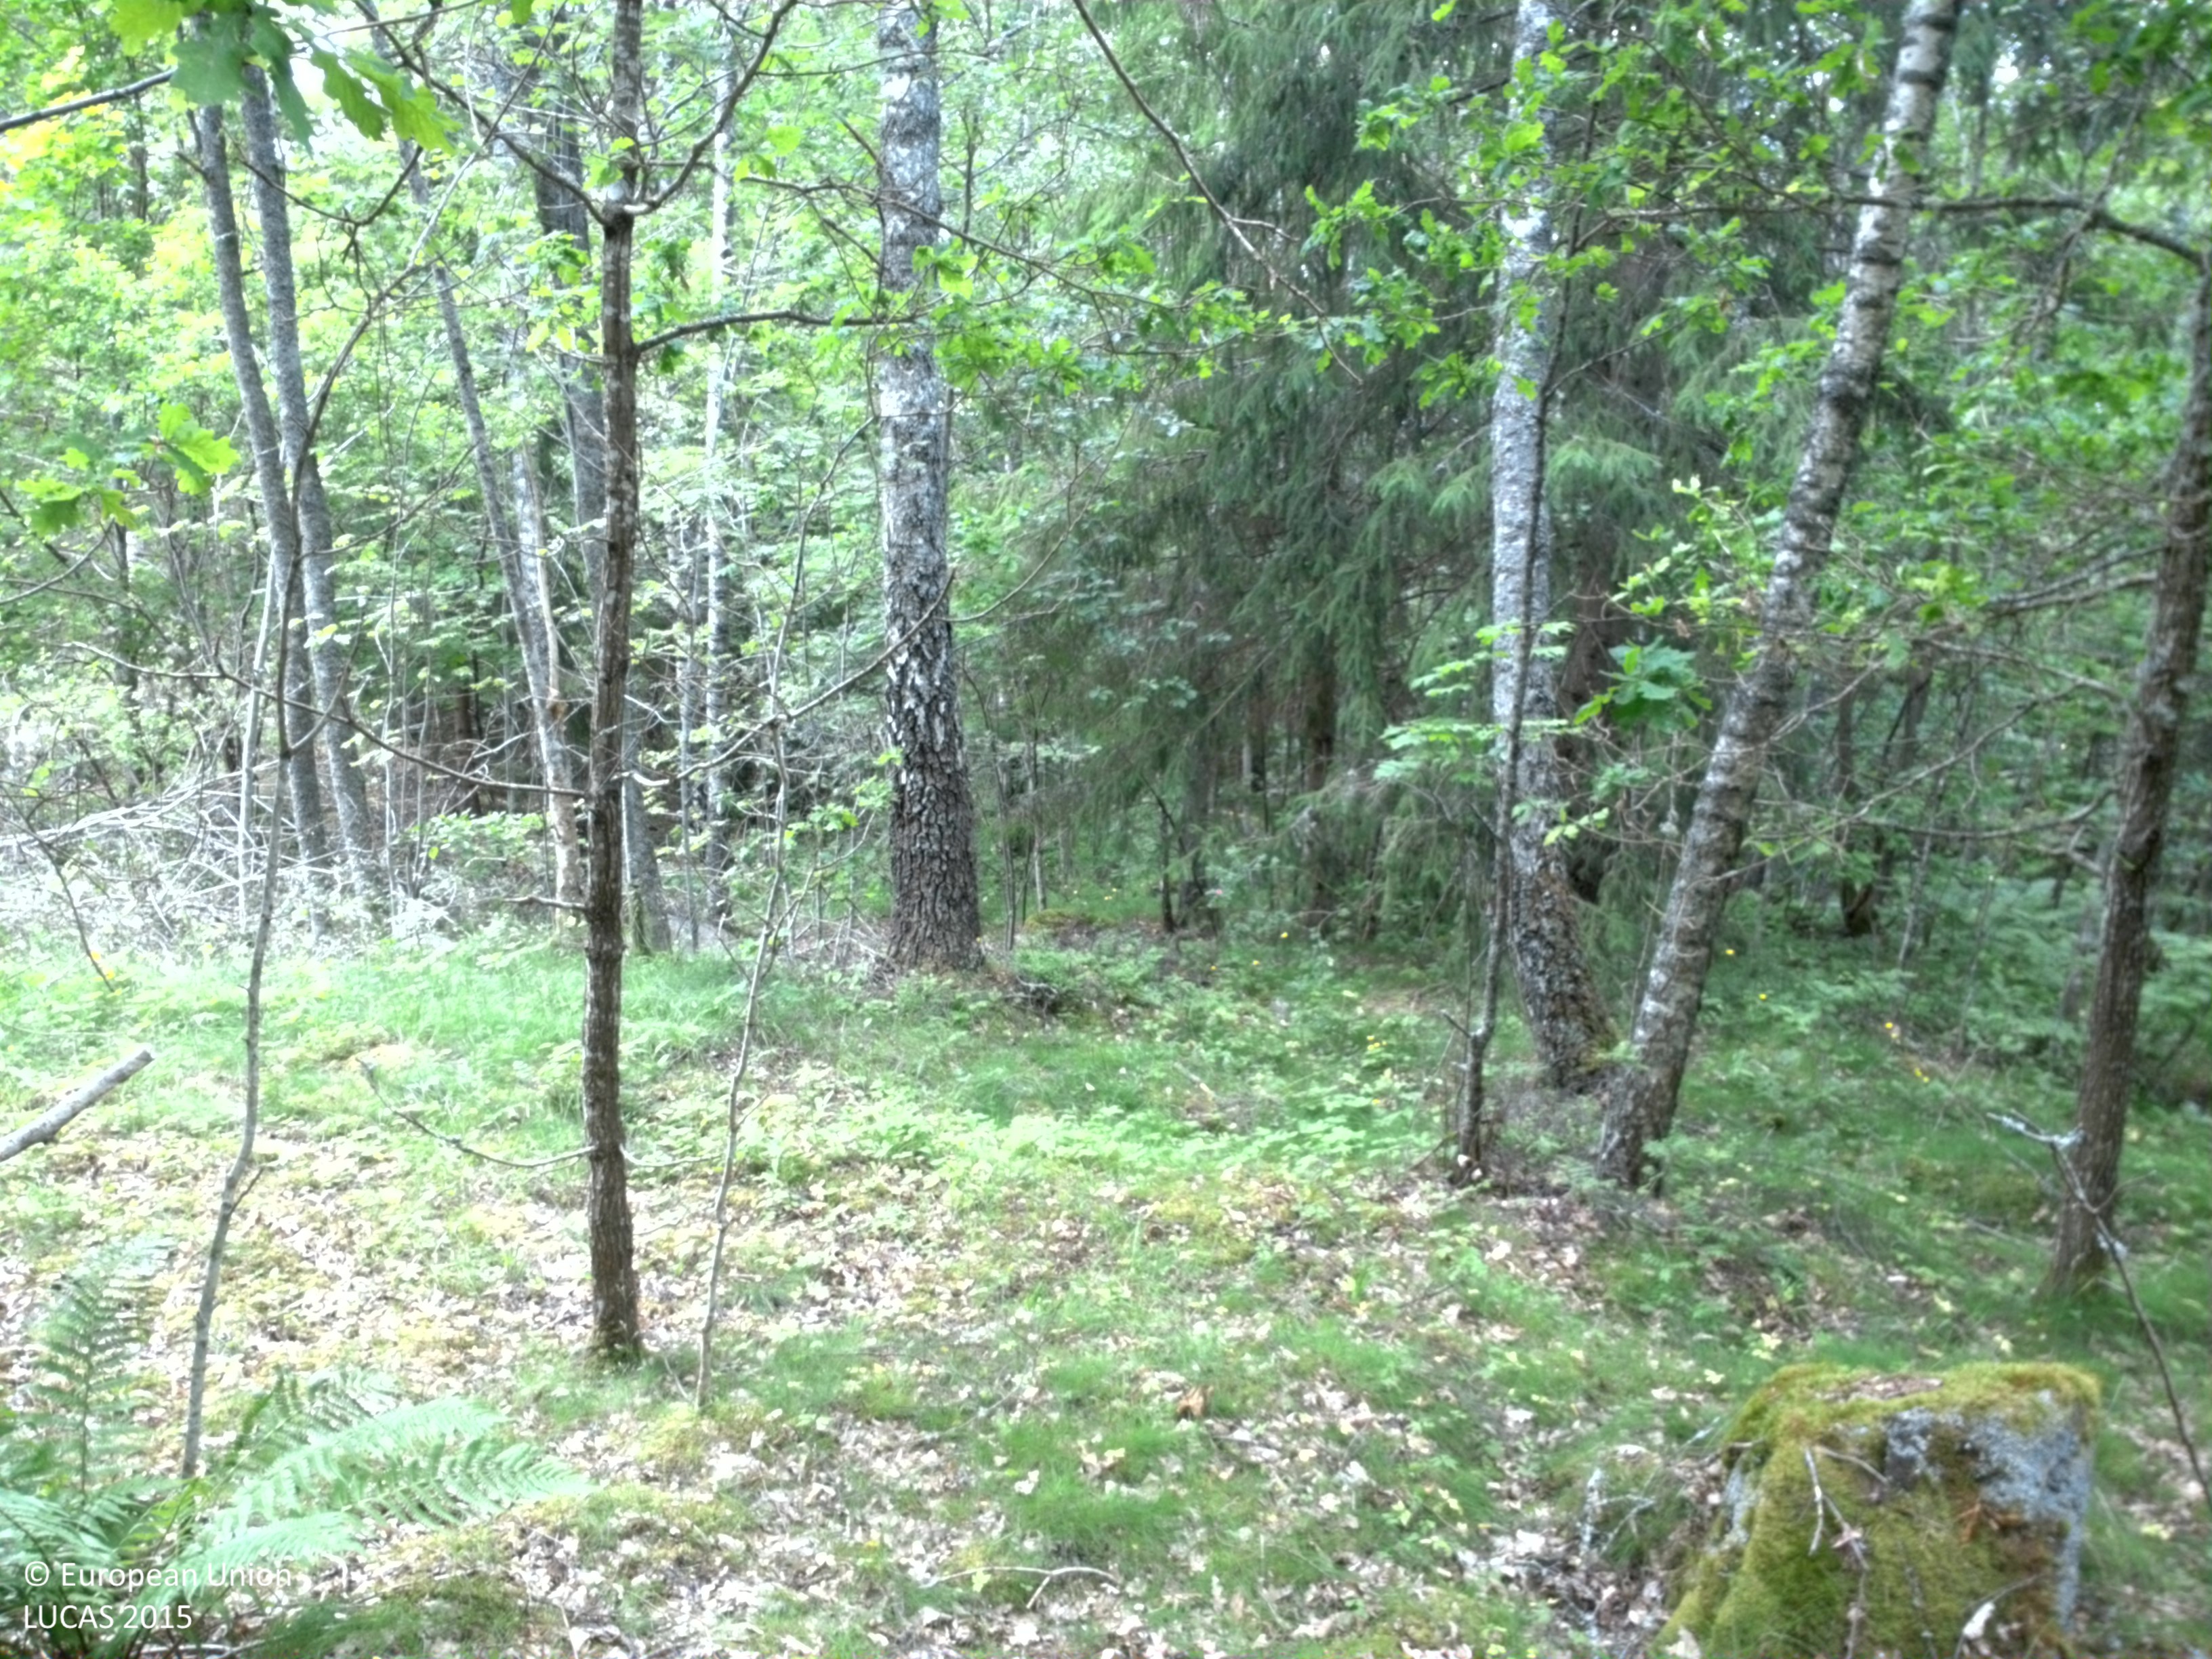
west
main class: Woodland
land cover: Spruce dominated mixed woodland
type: boreal forest
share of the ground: 50 - 75 %
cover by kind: coniferous forest trees 40 %, herbaceous plants 30 %, broadleaved forest trees 20 %, lichens and mosses 10 %
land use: Forestry
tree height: > 5 m
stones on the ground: < 10 %
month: June
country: SE
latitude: 58.7310
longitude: 15.6765
